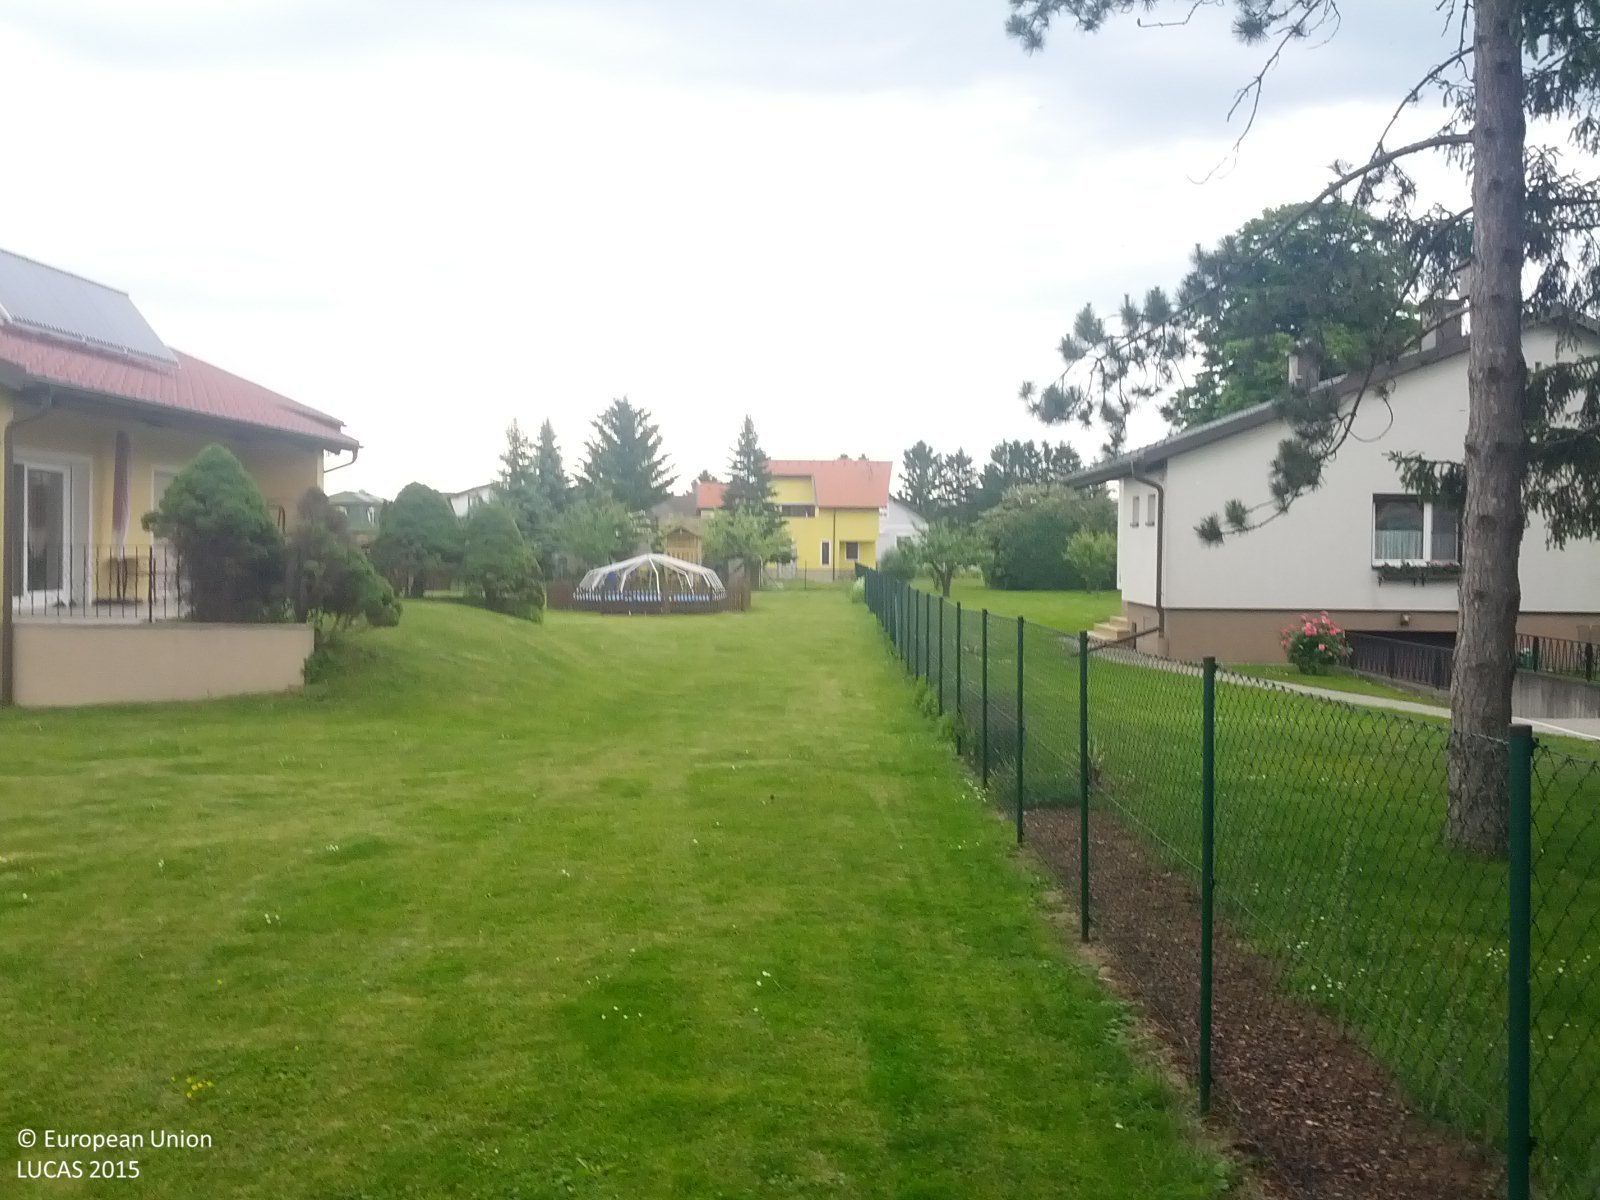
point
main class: Grassland
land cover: Grassland with sparse tree/shrub cover
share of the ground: > 75 %
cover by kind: herbaceous plants 90 %, coniferous forest trees 5 %, shrubs 5 %
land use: Residential
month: May
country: AT
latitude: 48.3230
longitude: 16.1409
